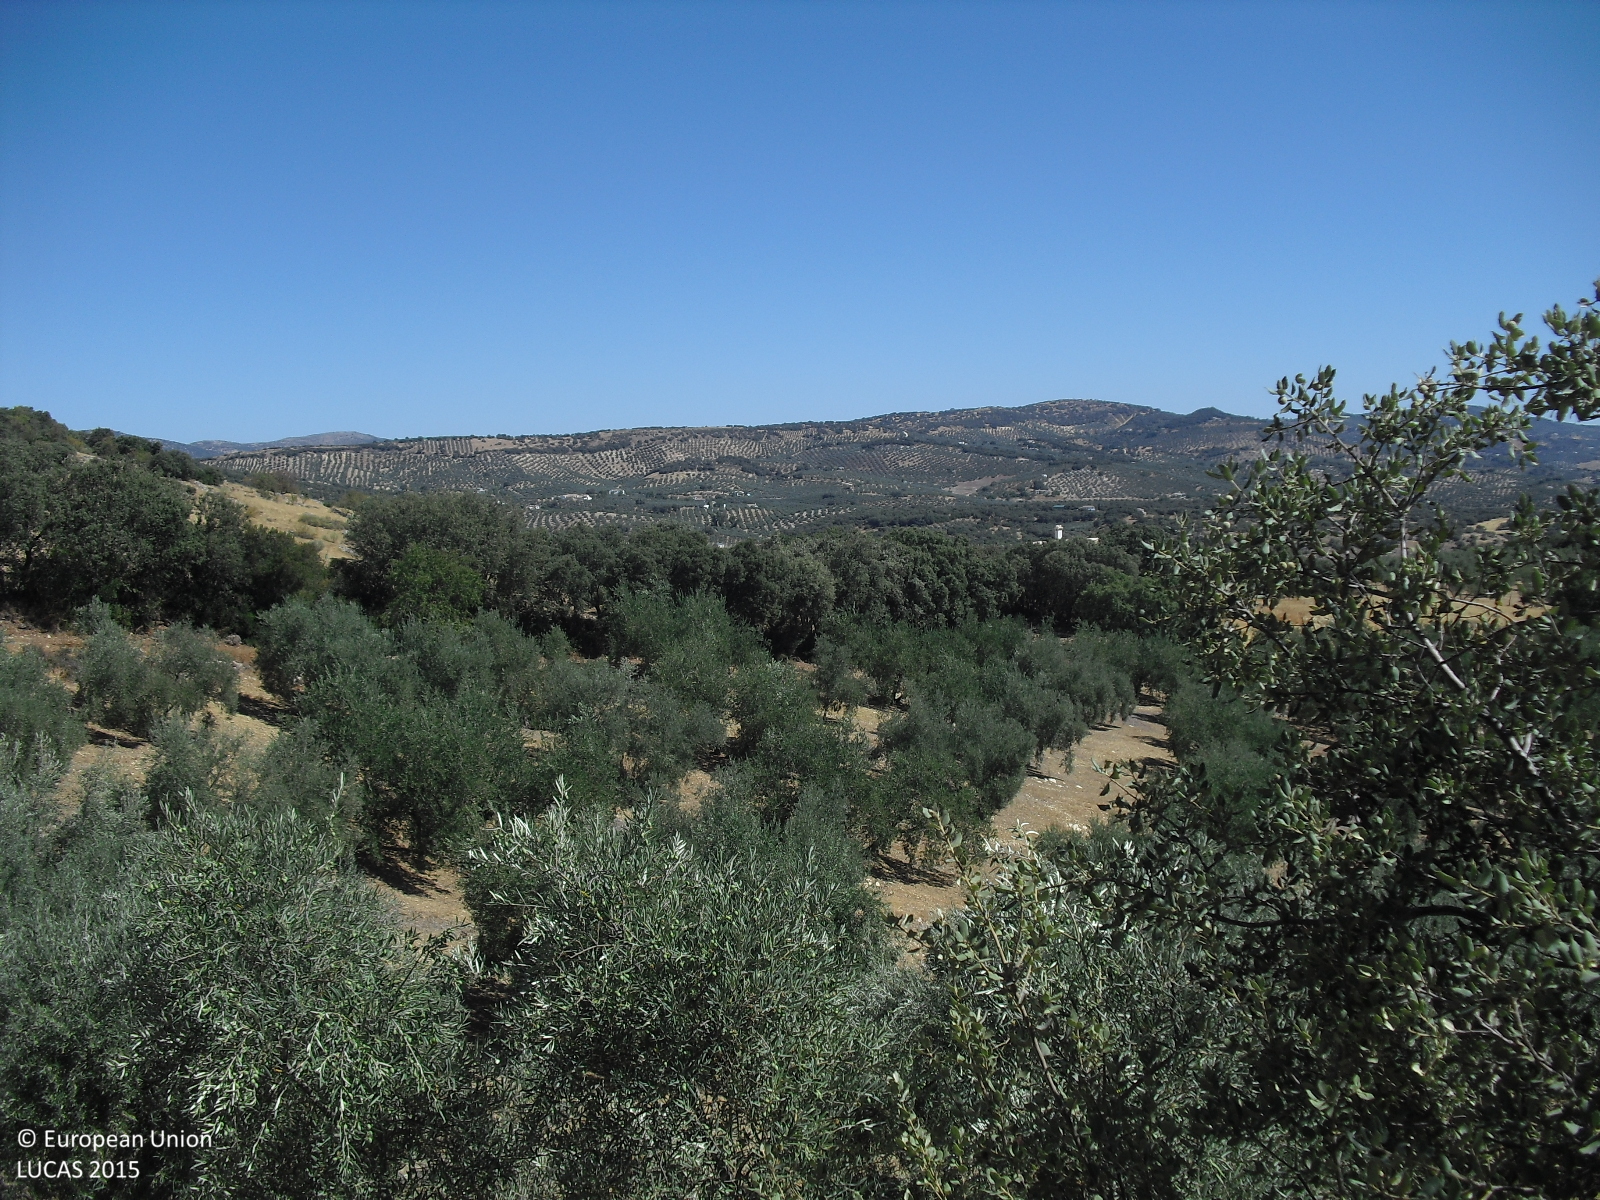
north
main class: Cropland
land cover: Olive groves
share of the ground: 25 - 50 %
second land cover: Other bare soil
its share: > 75 %
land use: Agriculture (excluding fallow land and kitchen gardens)
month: August
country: ES
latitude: 37.2964
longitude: -4.1088
